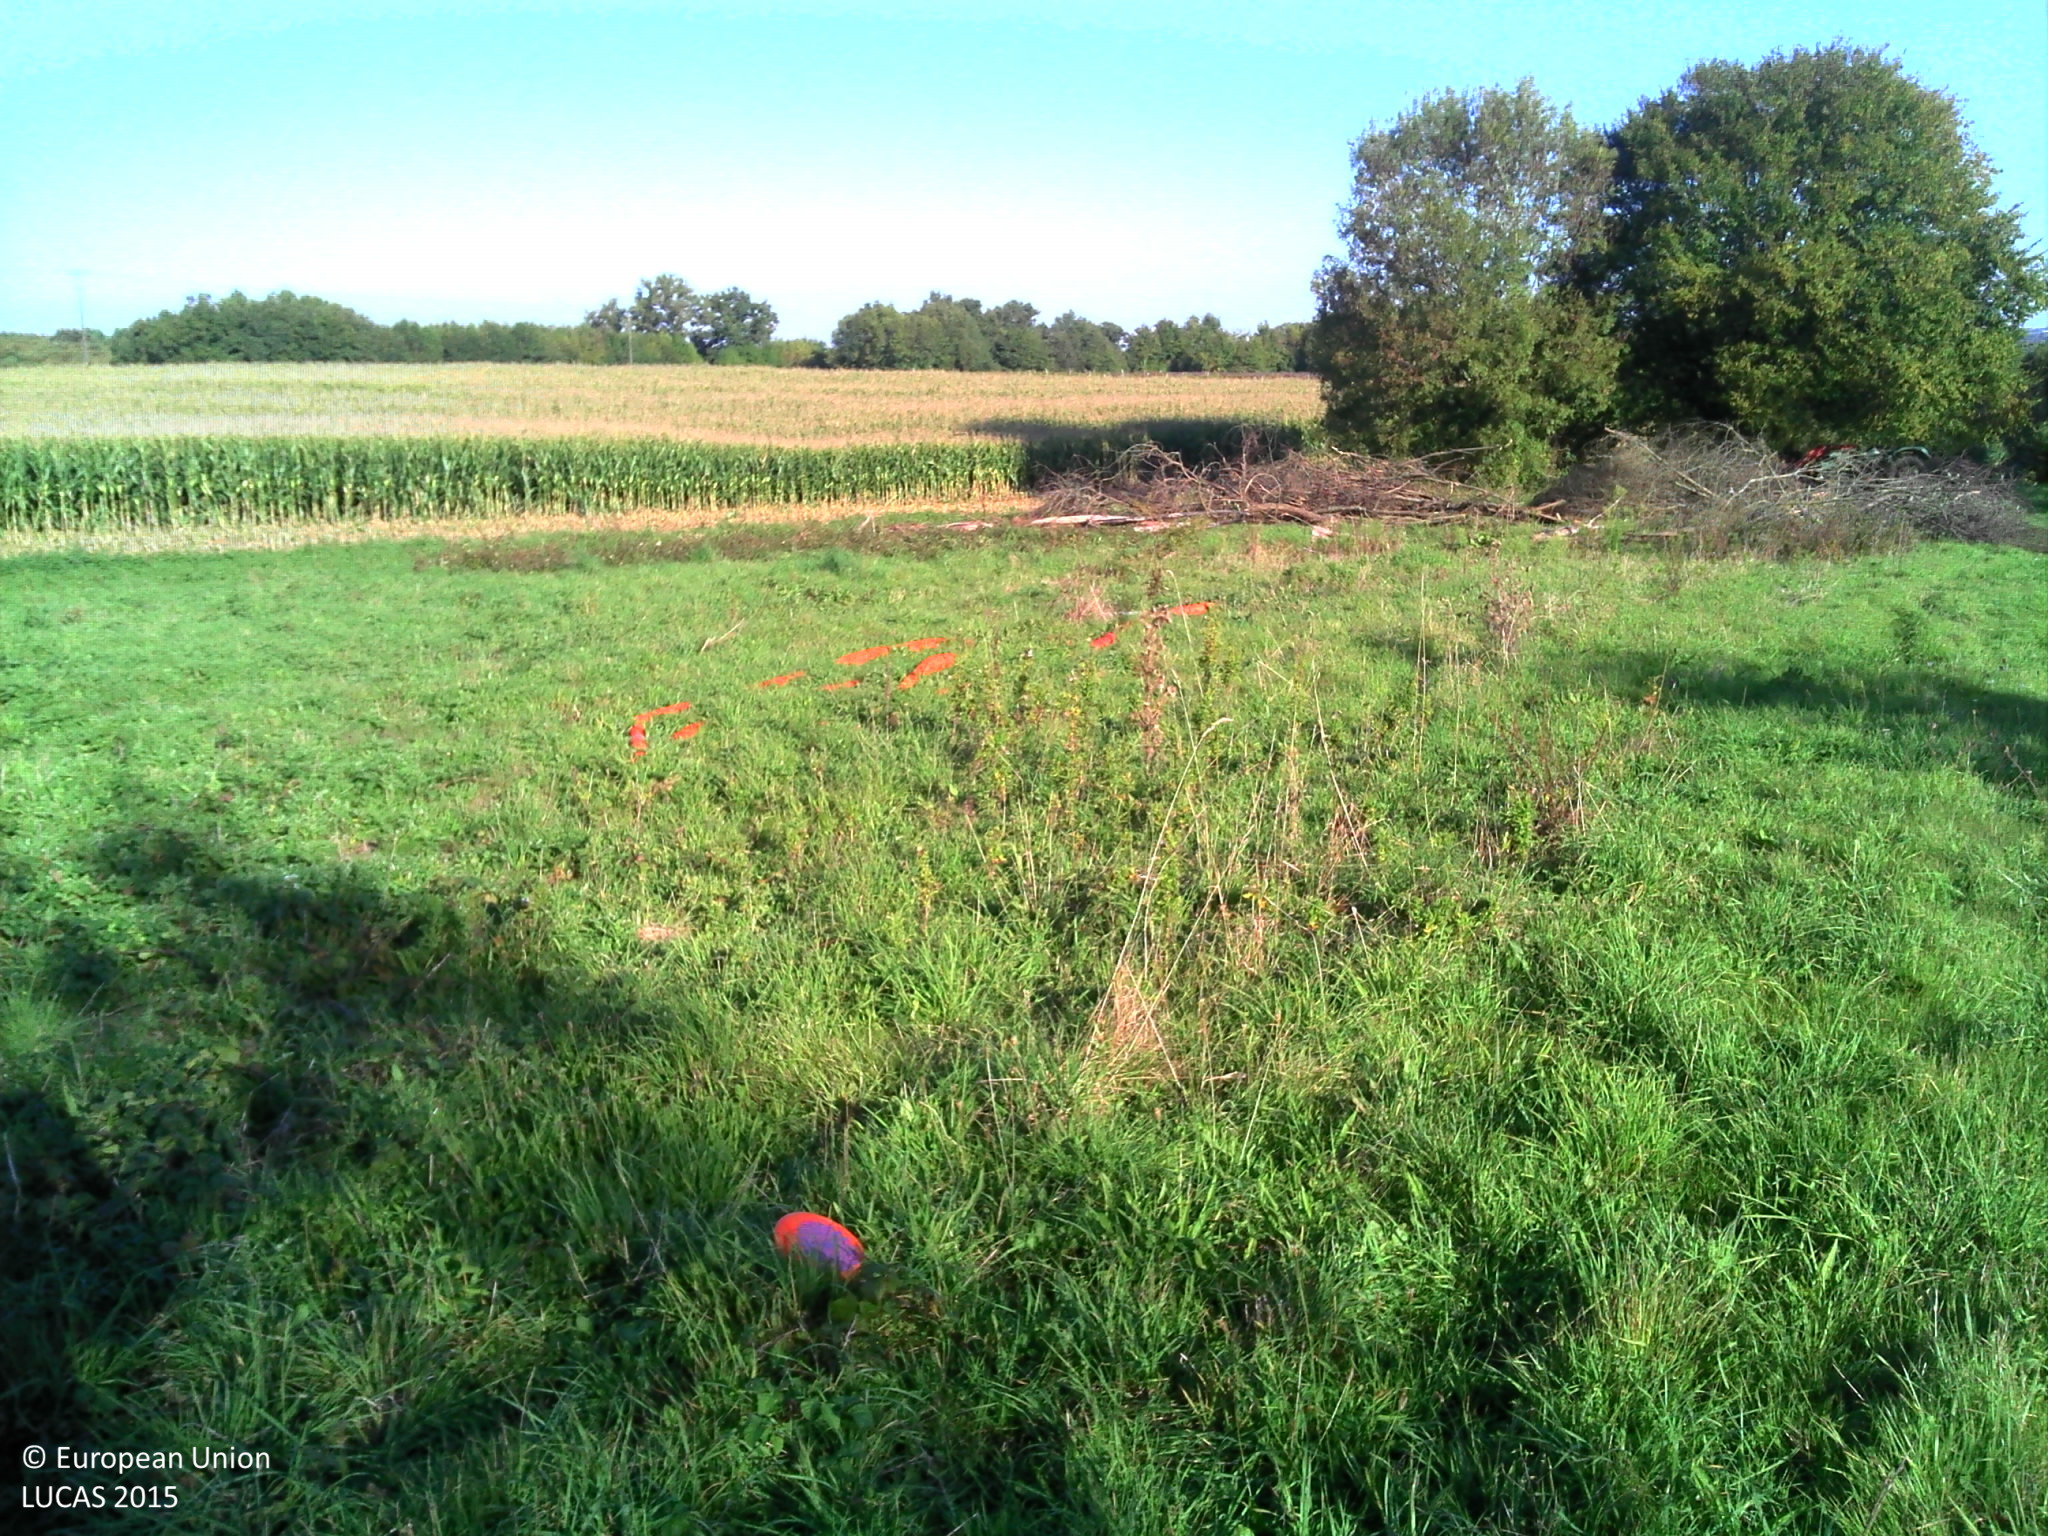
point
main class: Grassland
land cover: Grassland without tree/shrub cover
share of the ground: > 75 %
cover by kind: herbaceous plants 100 %
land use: Agriculture (excluding fallow land and kitchen gardens)
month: September
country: FR
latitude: 46.5932
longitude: -1.0625
